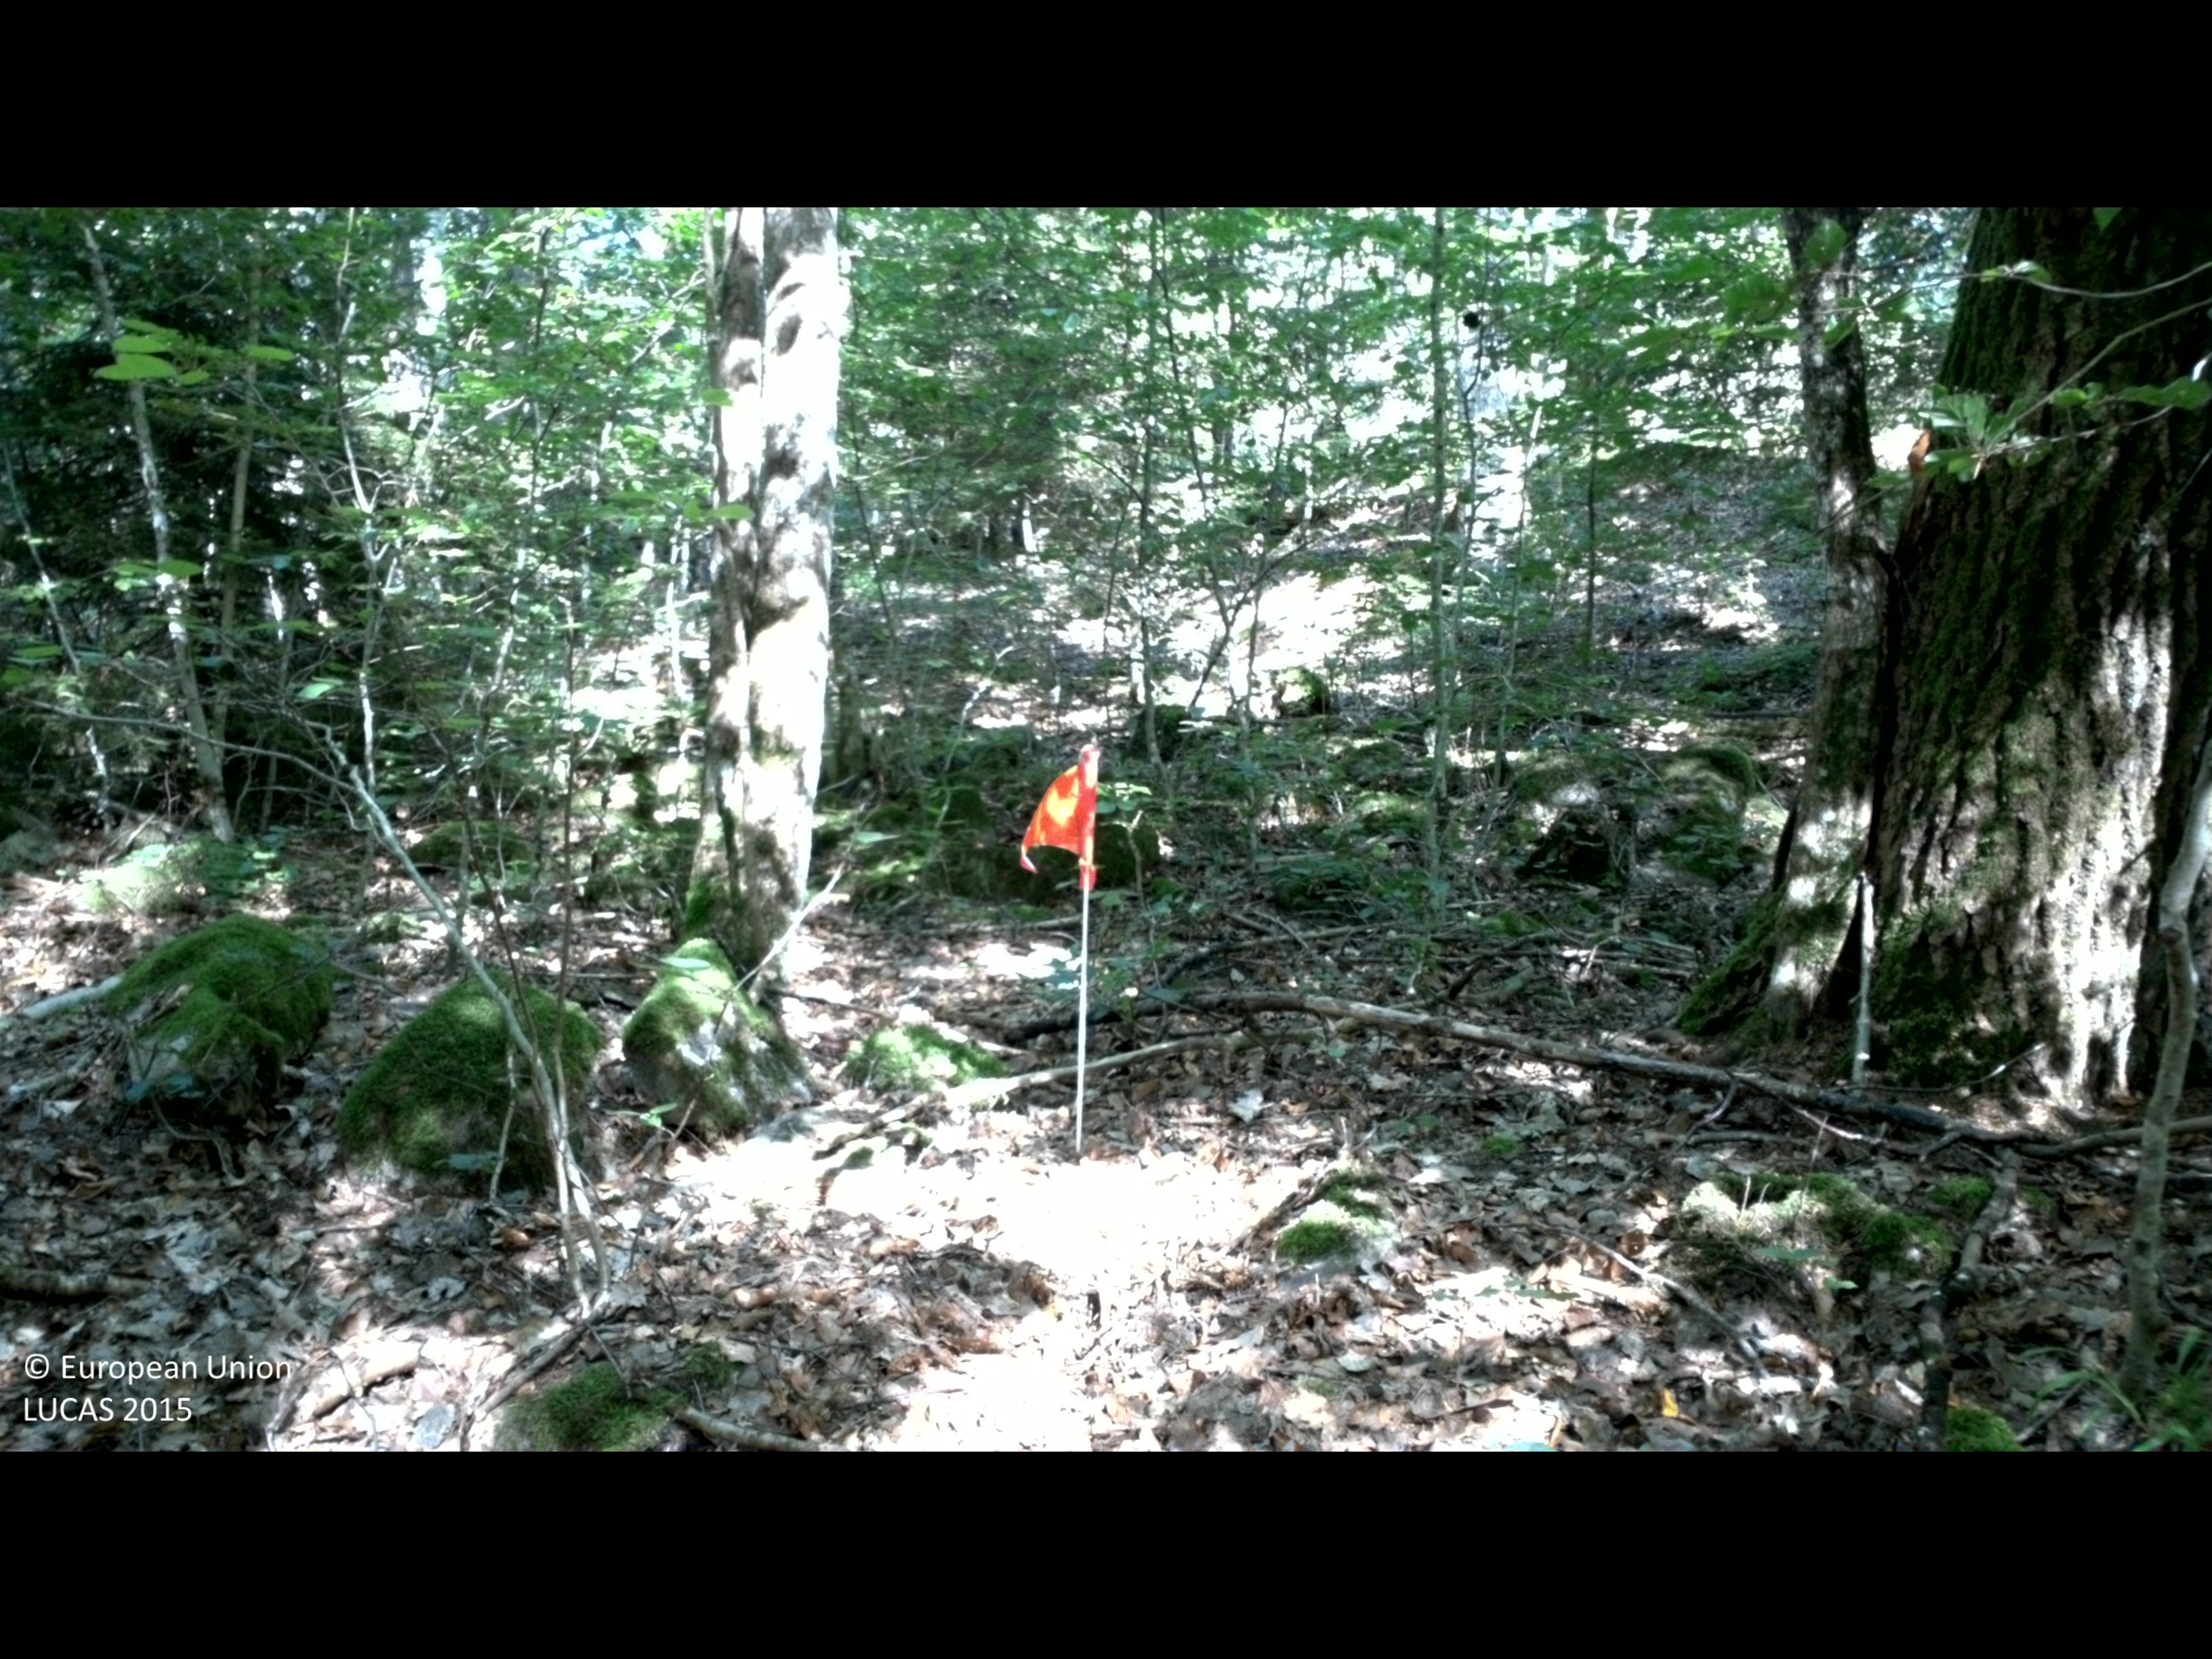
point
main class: Woodland
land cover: Broadleaved woodland
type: beech forest
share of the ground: > 75 %
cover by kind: broadleaved forest trees 75 %, coniferous forest trees 5 %, herbaceous plants 5 %
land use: Forestry
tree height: > 5 m
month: August
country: SE
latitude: 56.2640
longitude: 14.6963
